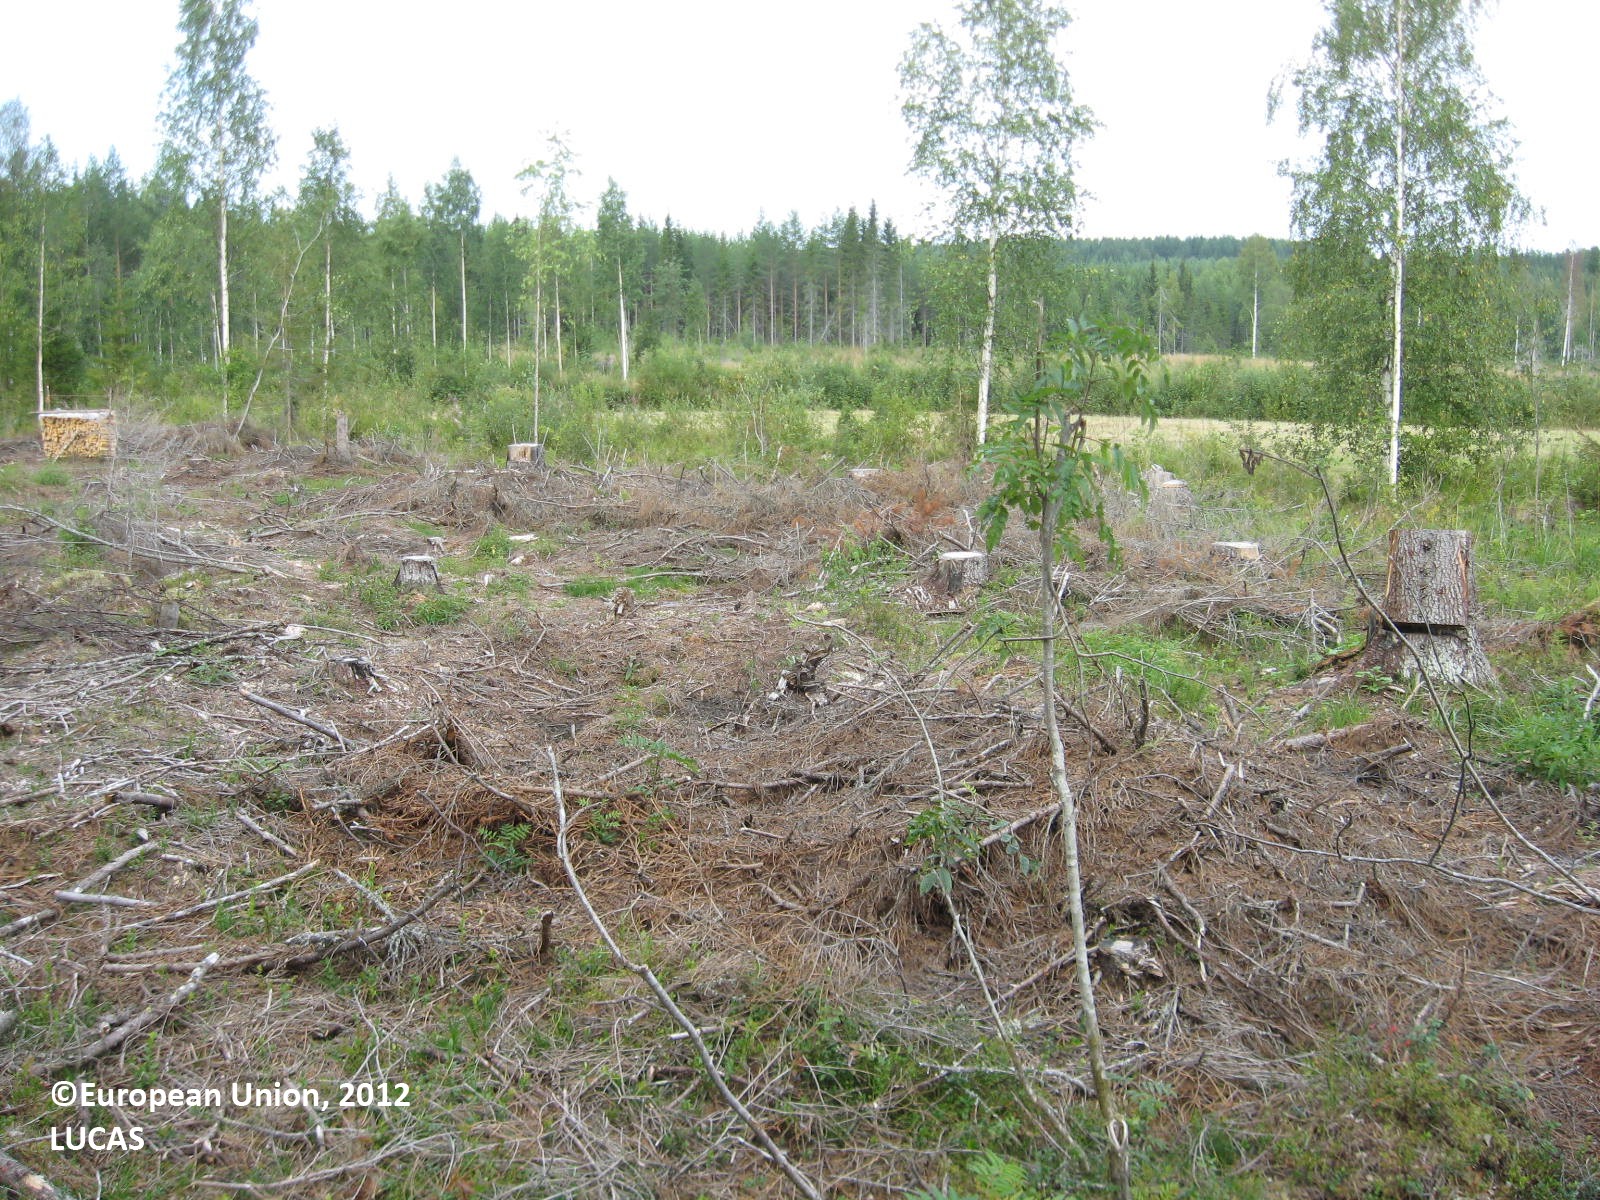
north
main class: Grassland
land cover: Grassland with sparse tree/shrub cover
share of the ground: 50 - 75 %
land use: Forestry
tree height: < 5 m
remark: Clear cut
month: August
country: FI
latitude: 63.3380
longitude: 29.6301
